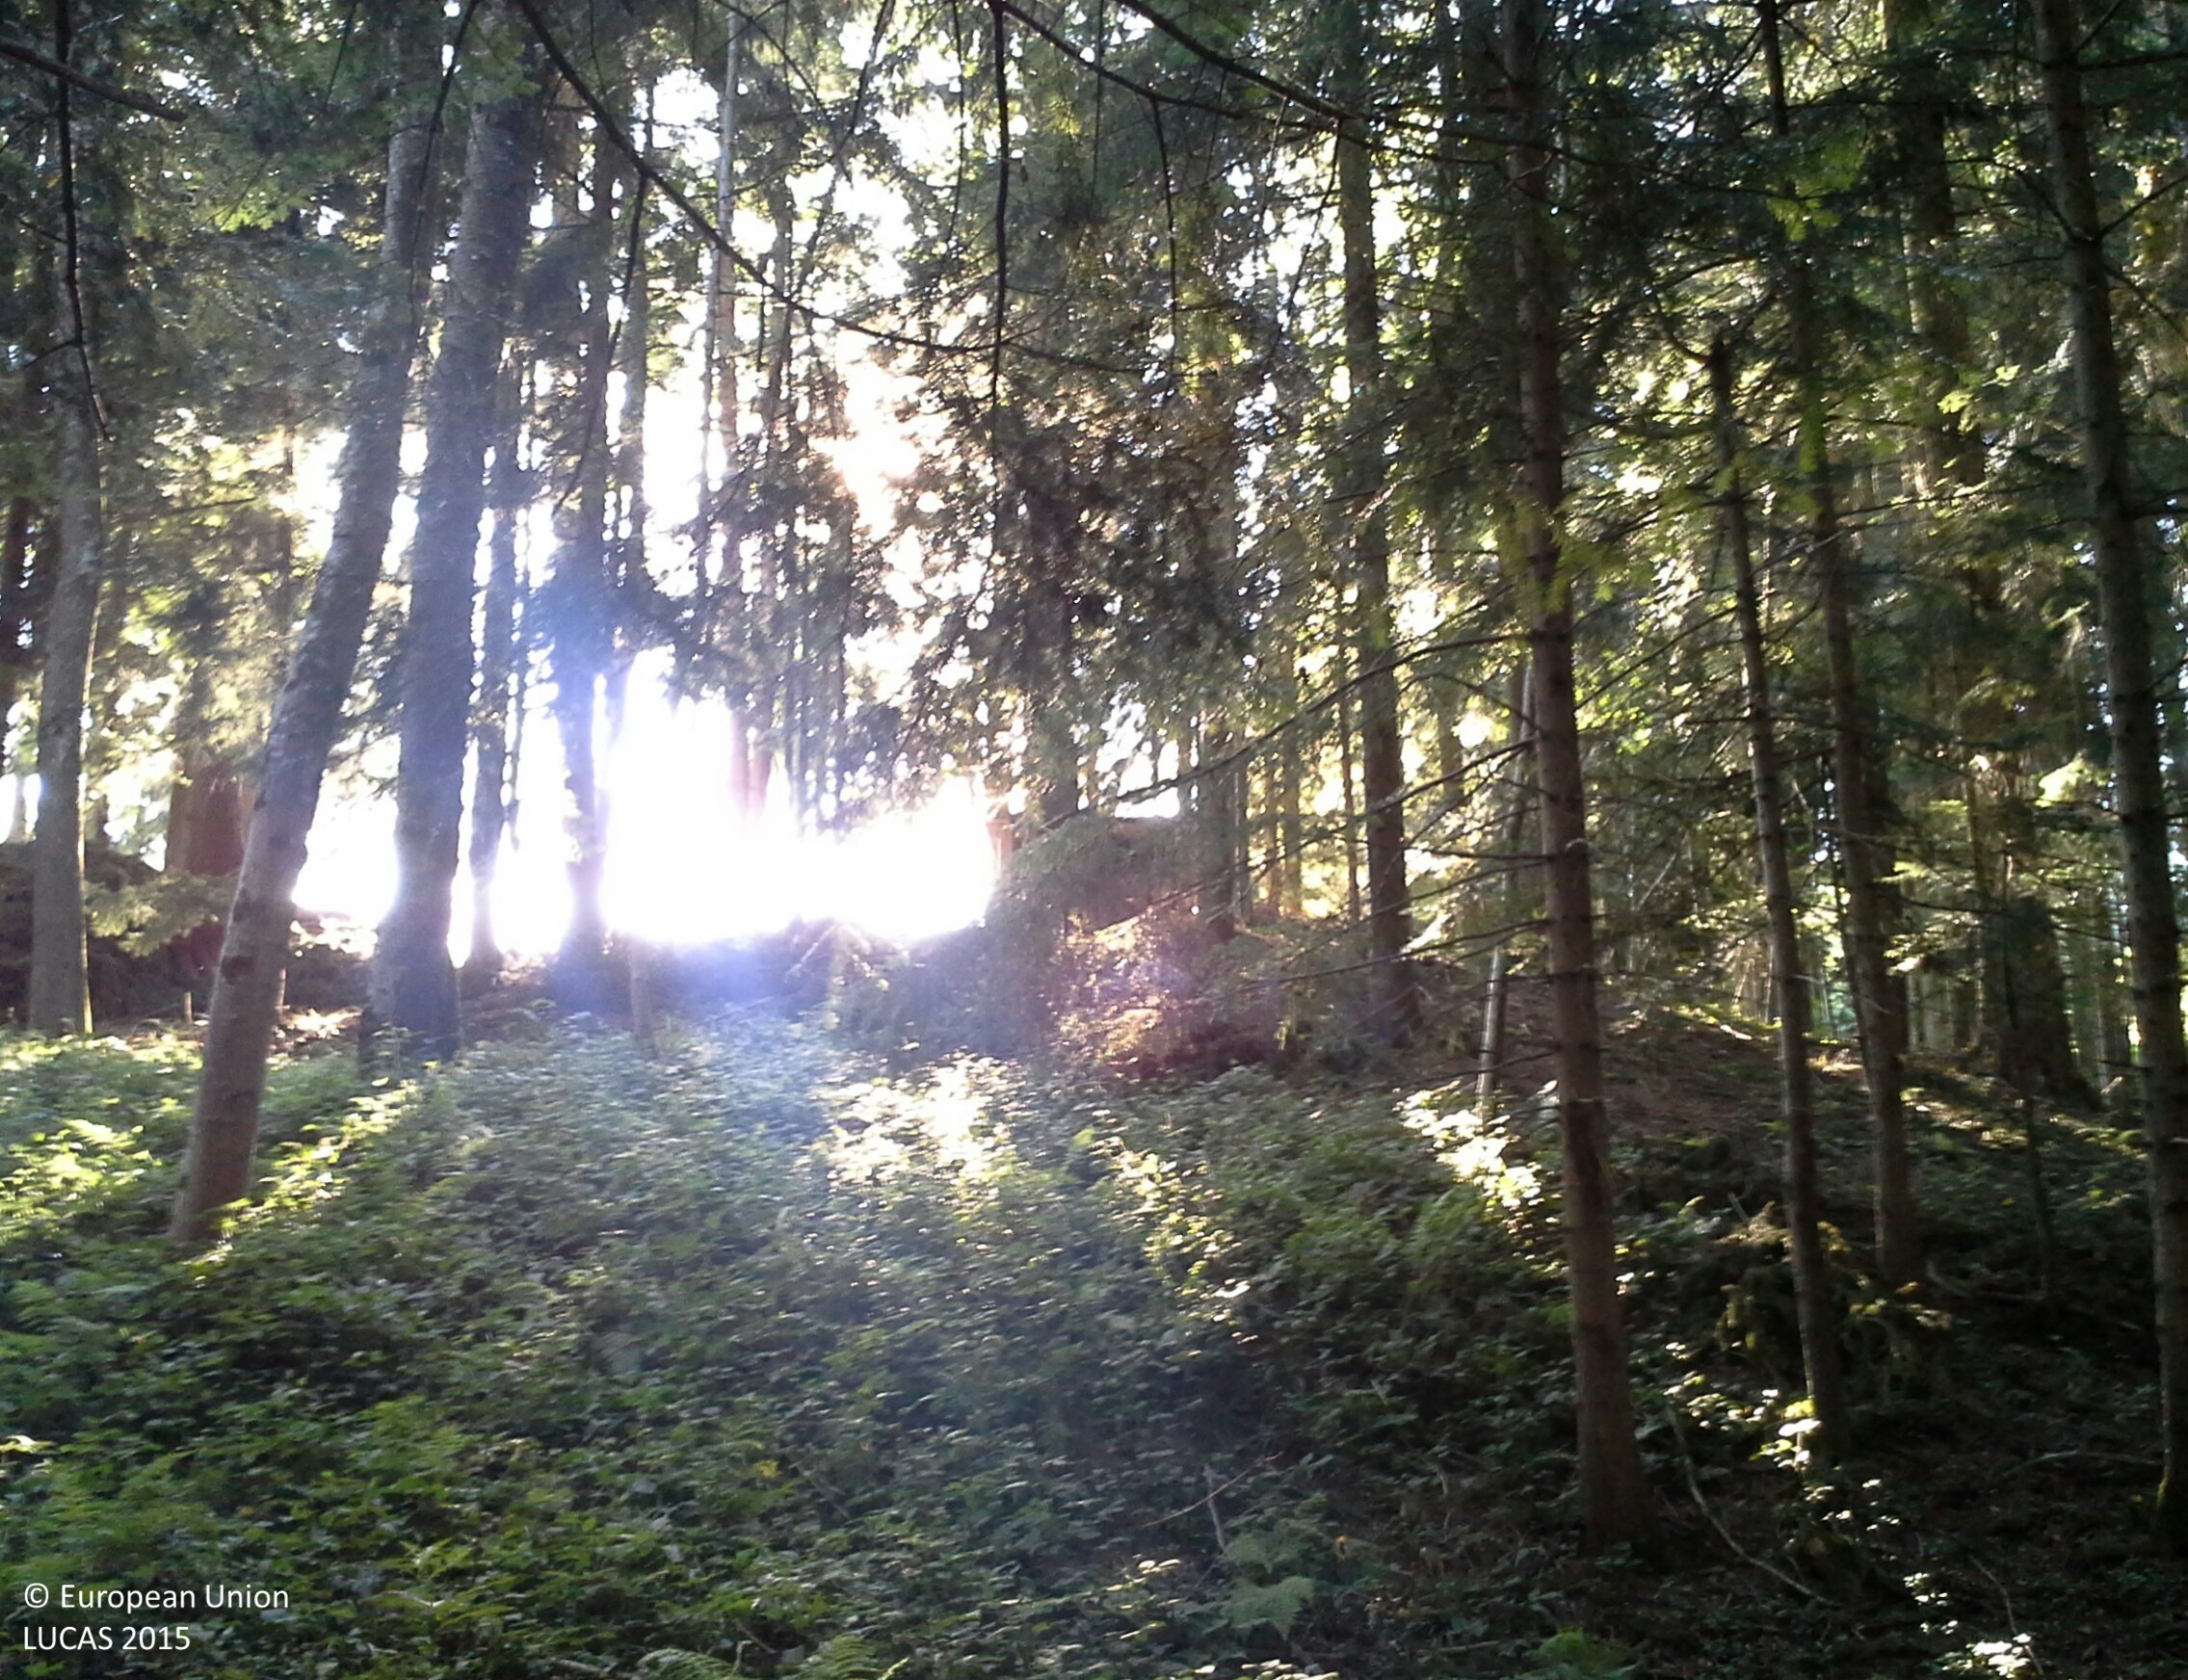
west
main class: Woodland
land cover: Other coniferous woodland
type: hemiboreal forest and nemoral coniferous forest and mixed broadleaved-coniferous forest
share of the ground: > 75 %
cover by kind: coniferous forest trees 75 %, broadleaved forest trees 15 %, shrubs 5 %, unconsolidated bare surface 5 %
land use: Forestry
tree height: > 5 m
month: July
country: AT
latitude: 47.9744
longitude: 14.8096
